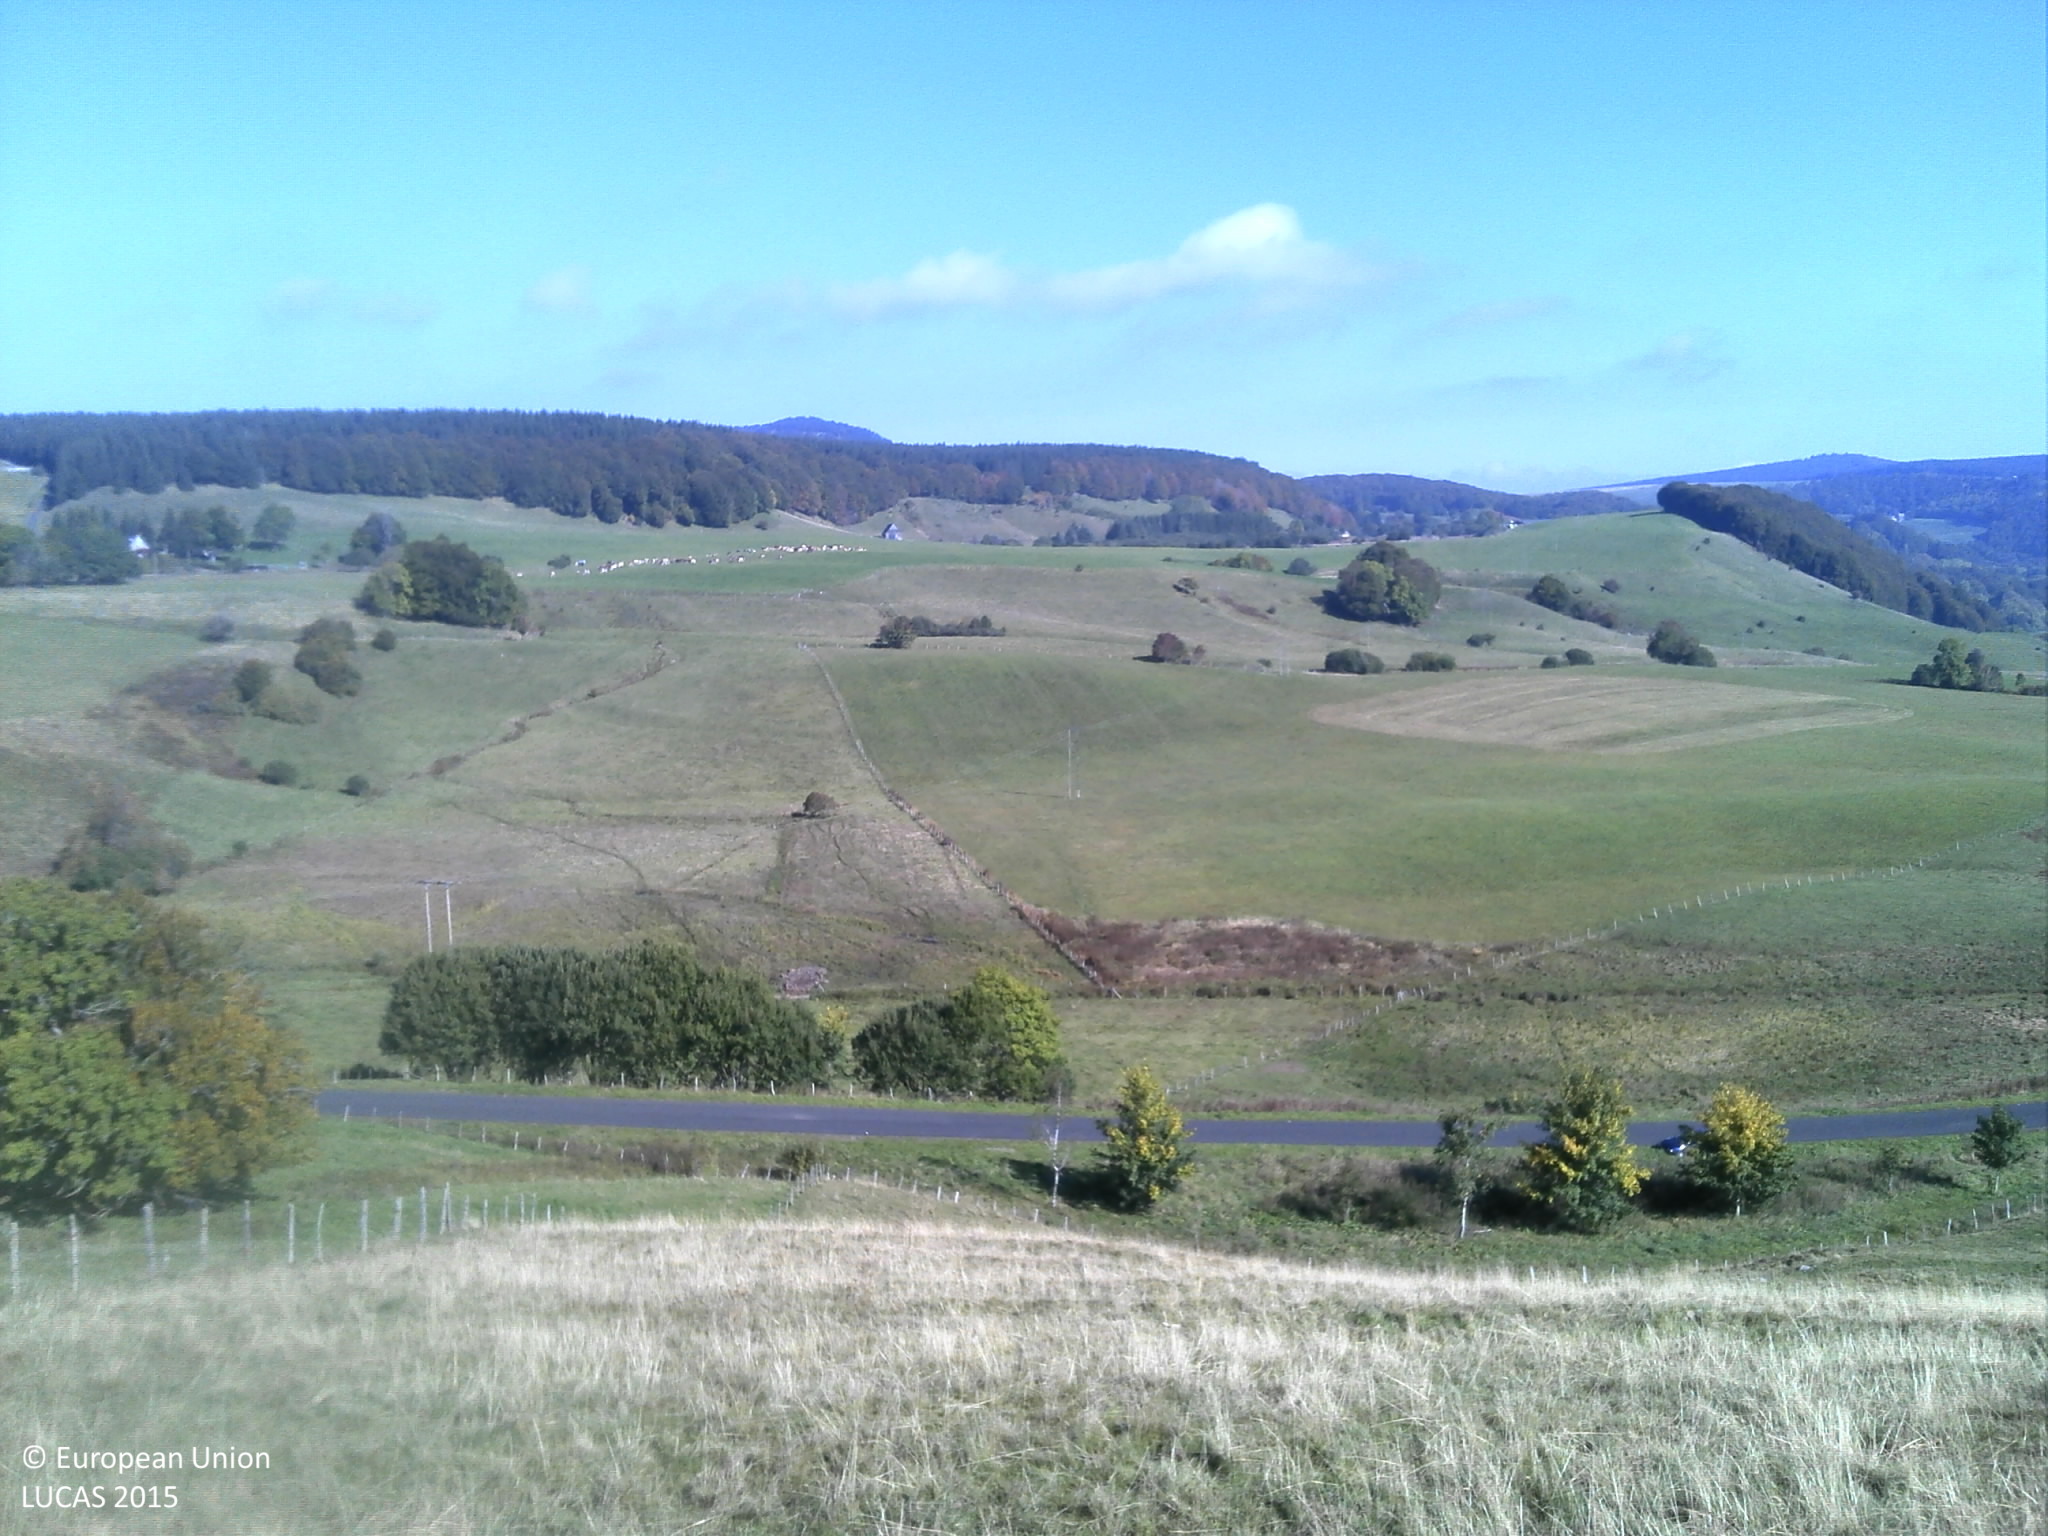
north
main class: Grassland
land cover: Grassland without tree/shrub cover
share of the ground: > 75 %
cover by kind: herbaceous plants 100 %
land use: Agriculture (excluding fallow land and kitchen gardens)
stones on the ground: < 10 %
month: October
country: FR
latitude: 45.4284
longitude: 2.9066
